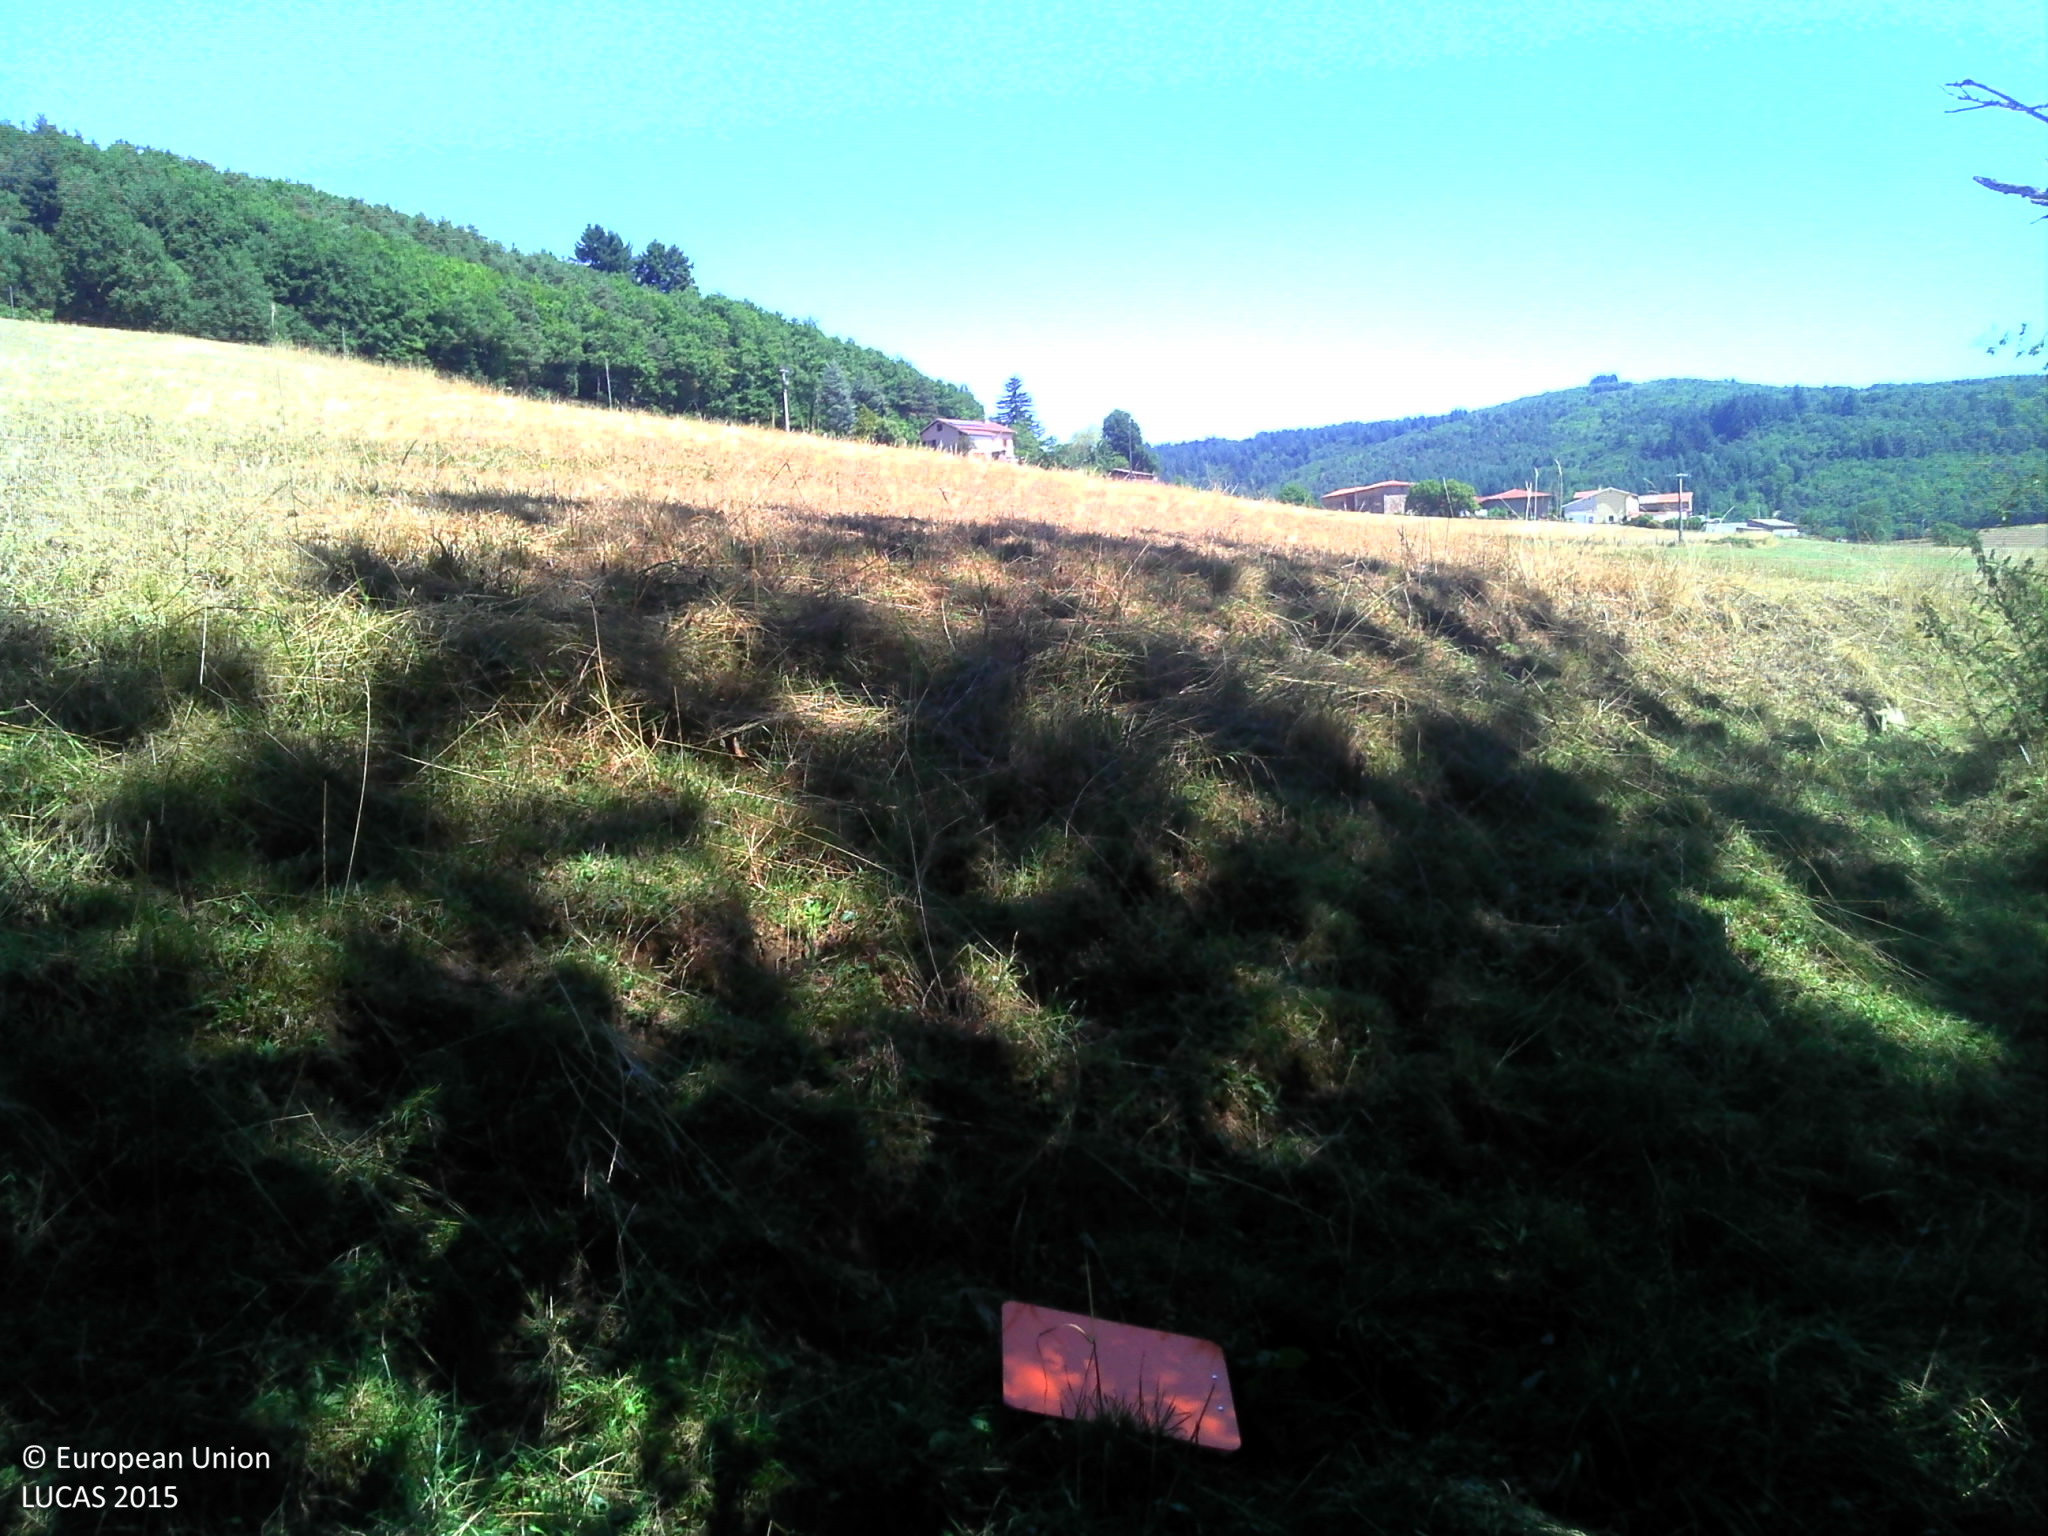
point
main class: Grassland
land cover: Grassland without tree/shrub cover
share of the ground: > 75 %
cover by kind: herbaceous plants 100 %
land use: Agriculture (excluding fallow land and kitchen gardens)
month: August
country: FR
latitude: 45.6885
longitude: 4.5461
